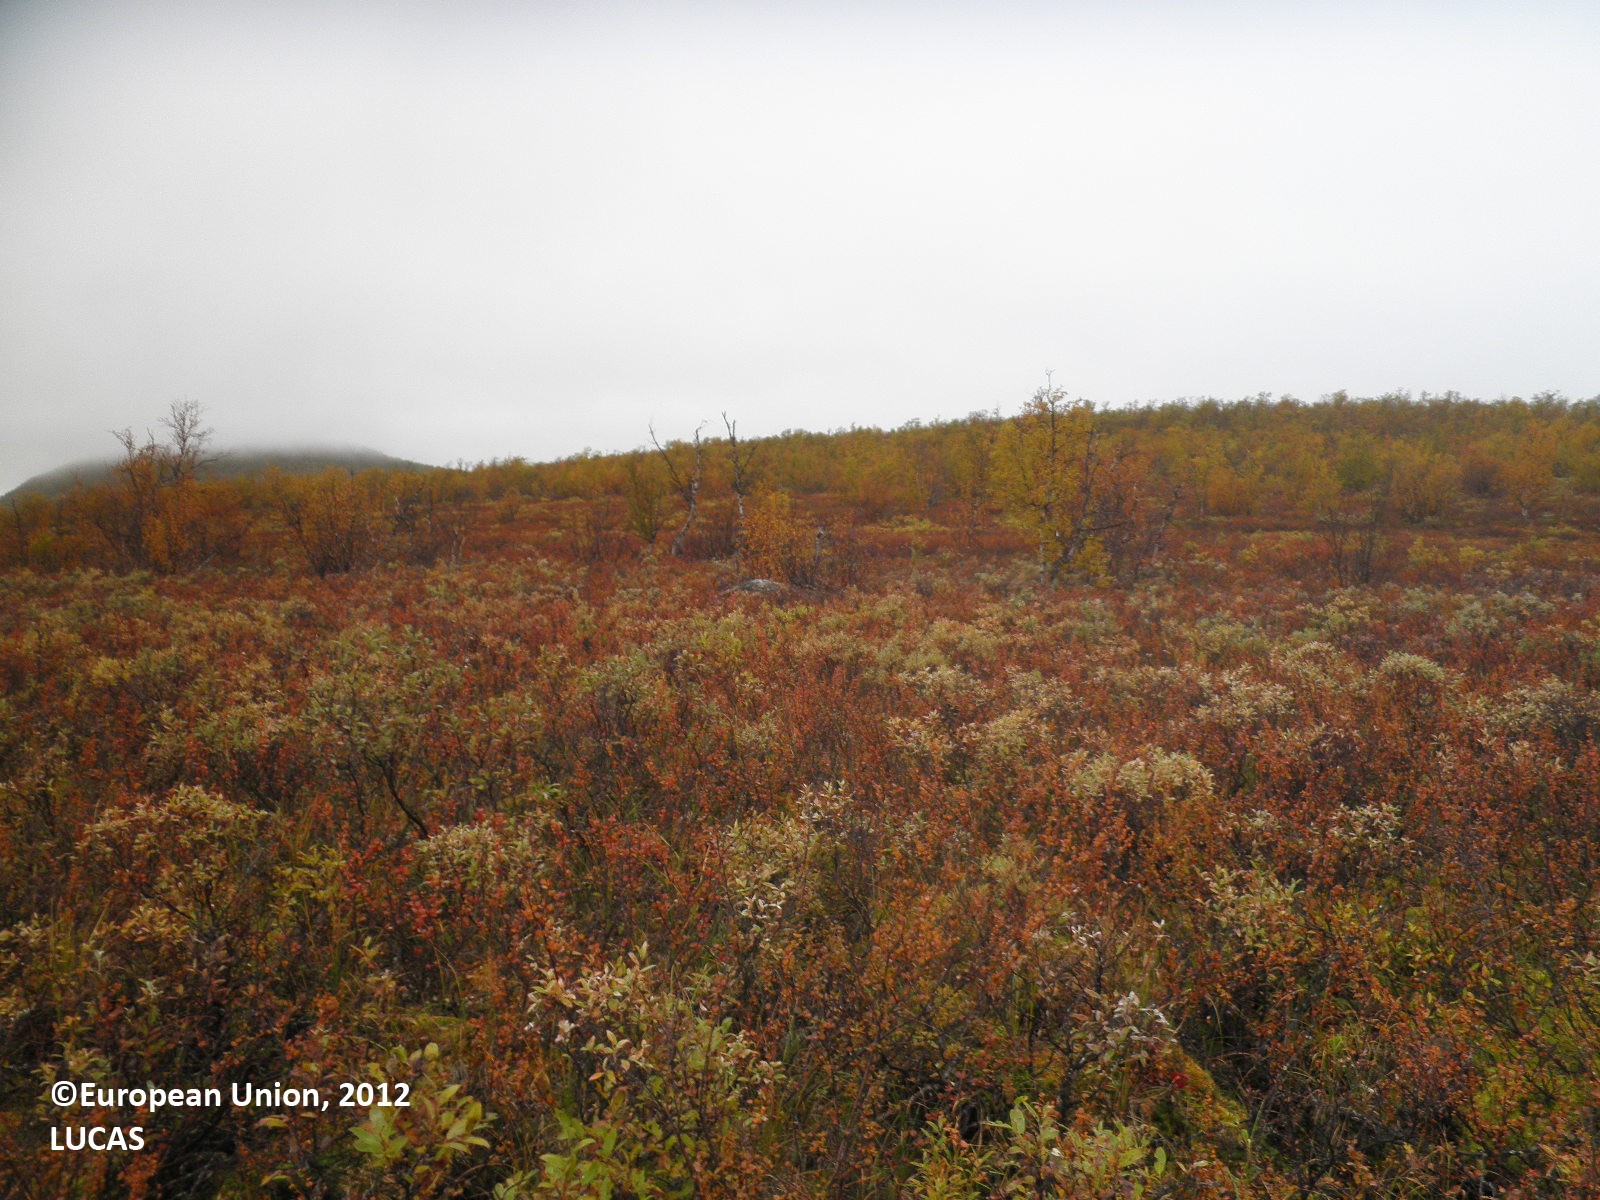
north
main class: Shrubland
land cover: Shrubland without tree cover
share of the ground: > 75 %
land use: Semi-natural and natural areas not in use
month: September
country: FI
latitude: 68.8188
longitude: 21.2137
